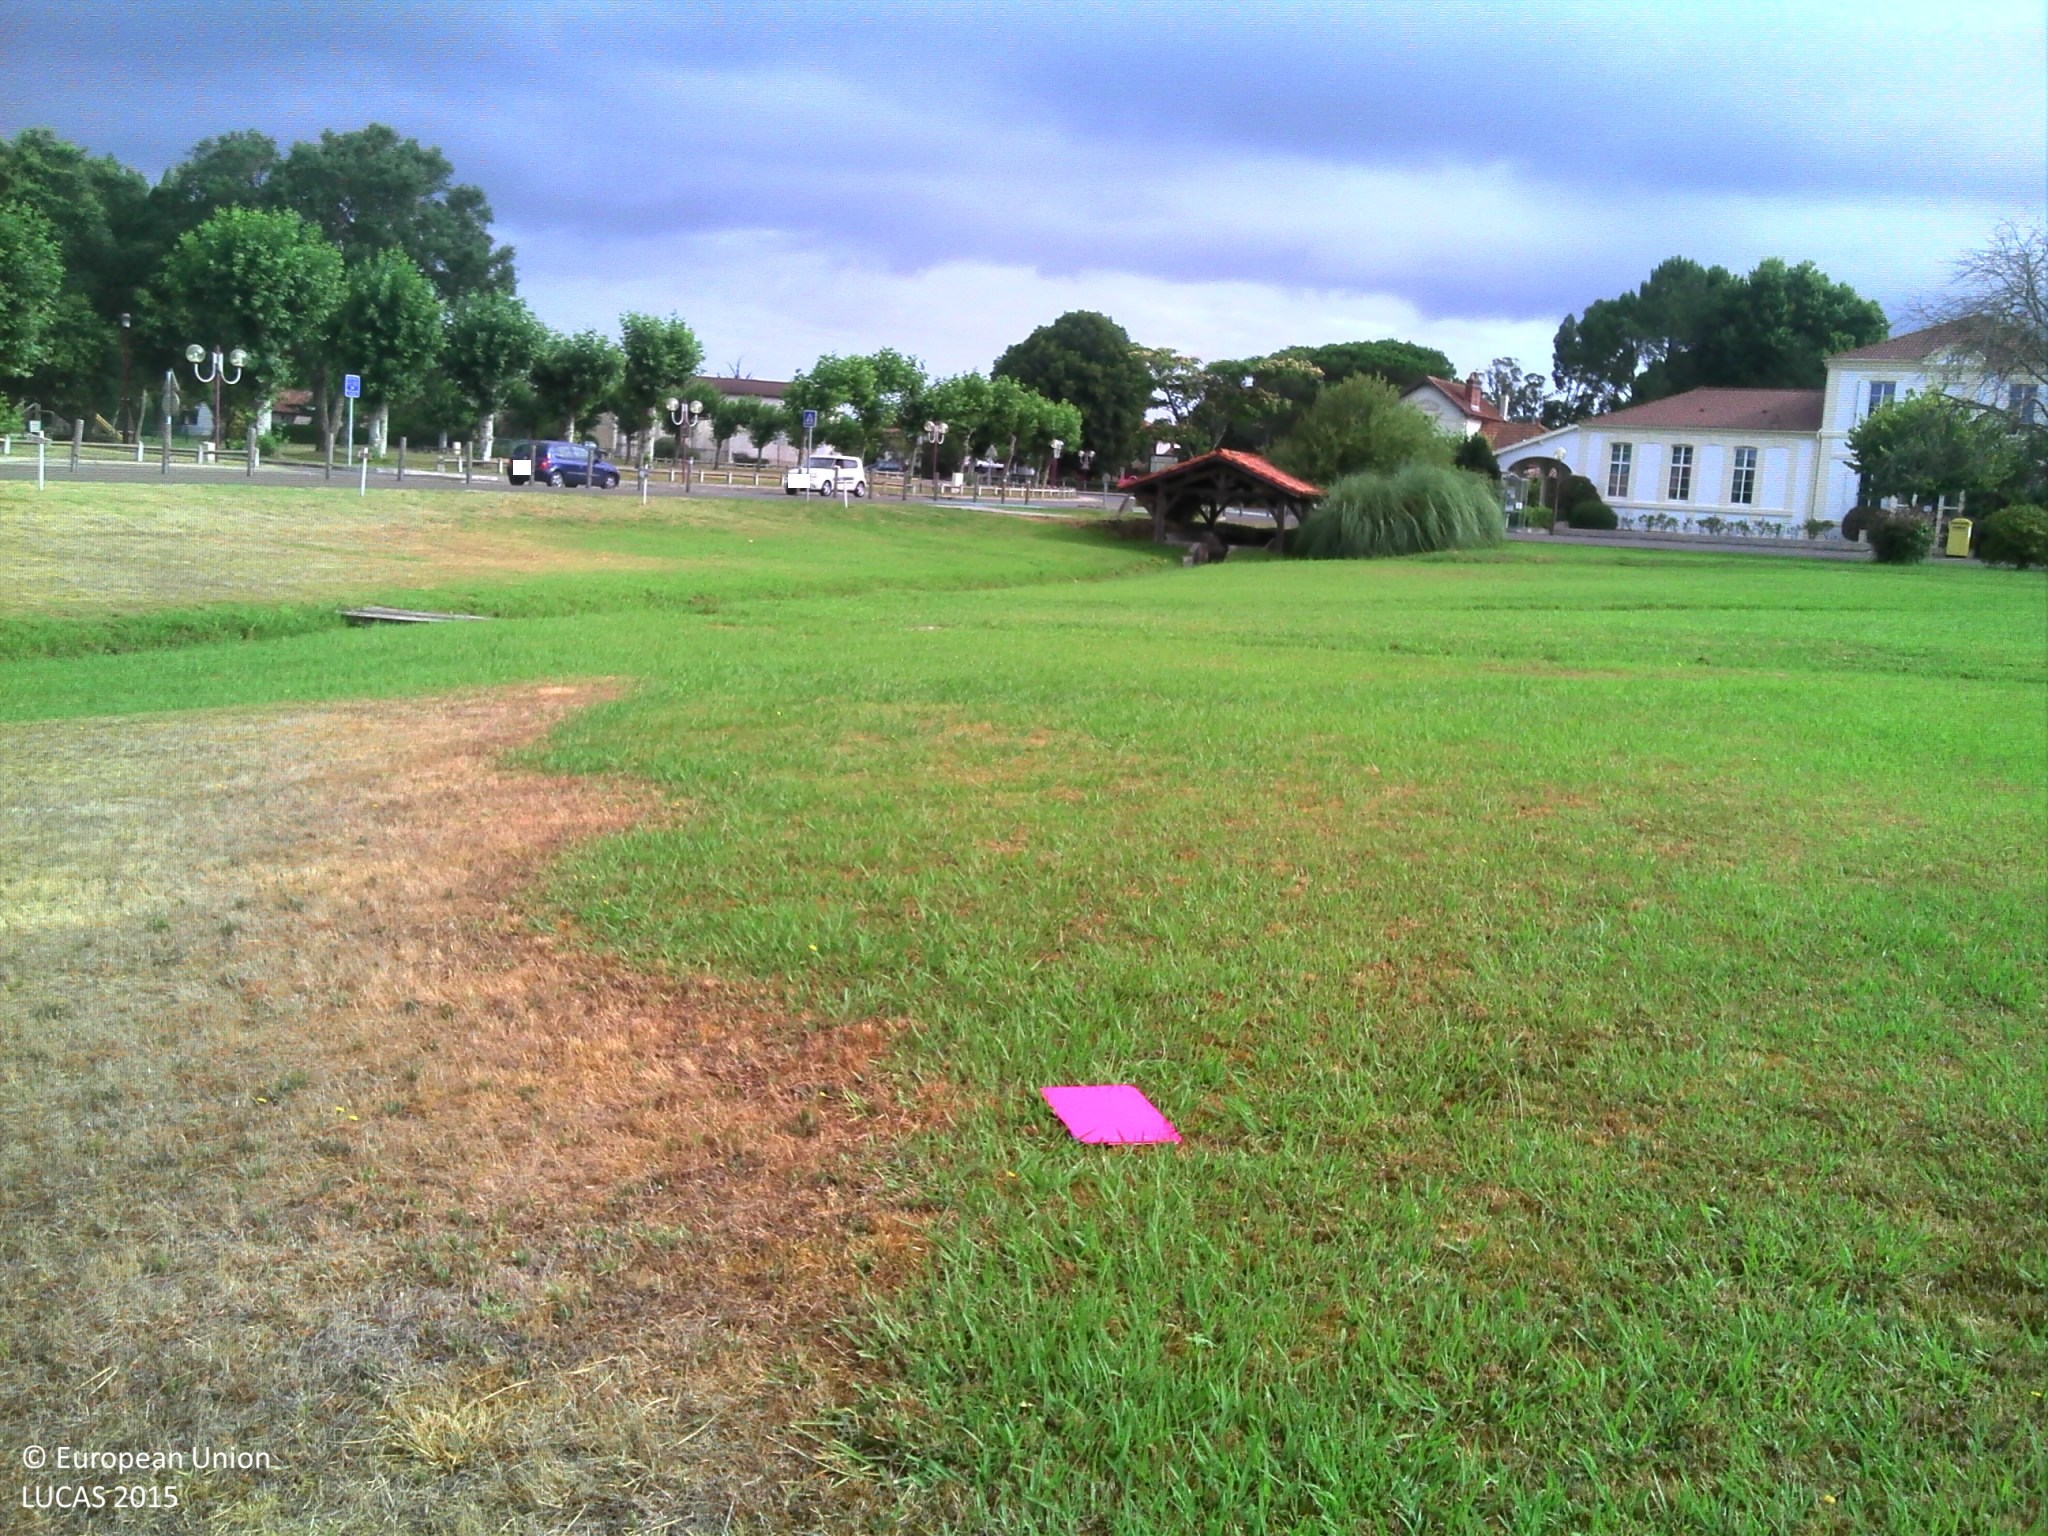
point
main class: Grassland
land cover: Grassland without tree/shrub cover
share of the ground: > 75 %
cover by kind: herbaceous plants 100 %
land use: Residential
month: July
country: FR
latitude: 44.2717
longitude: -1.1835
